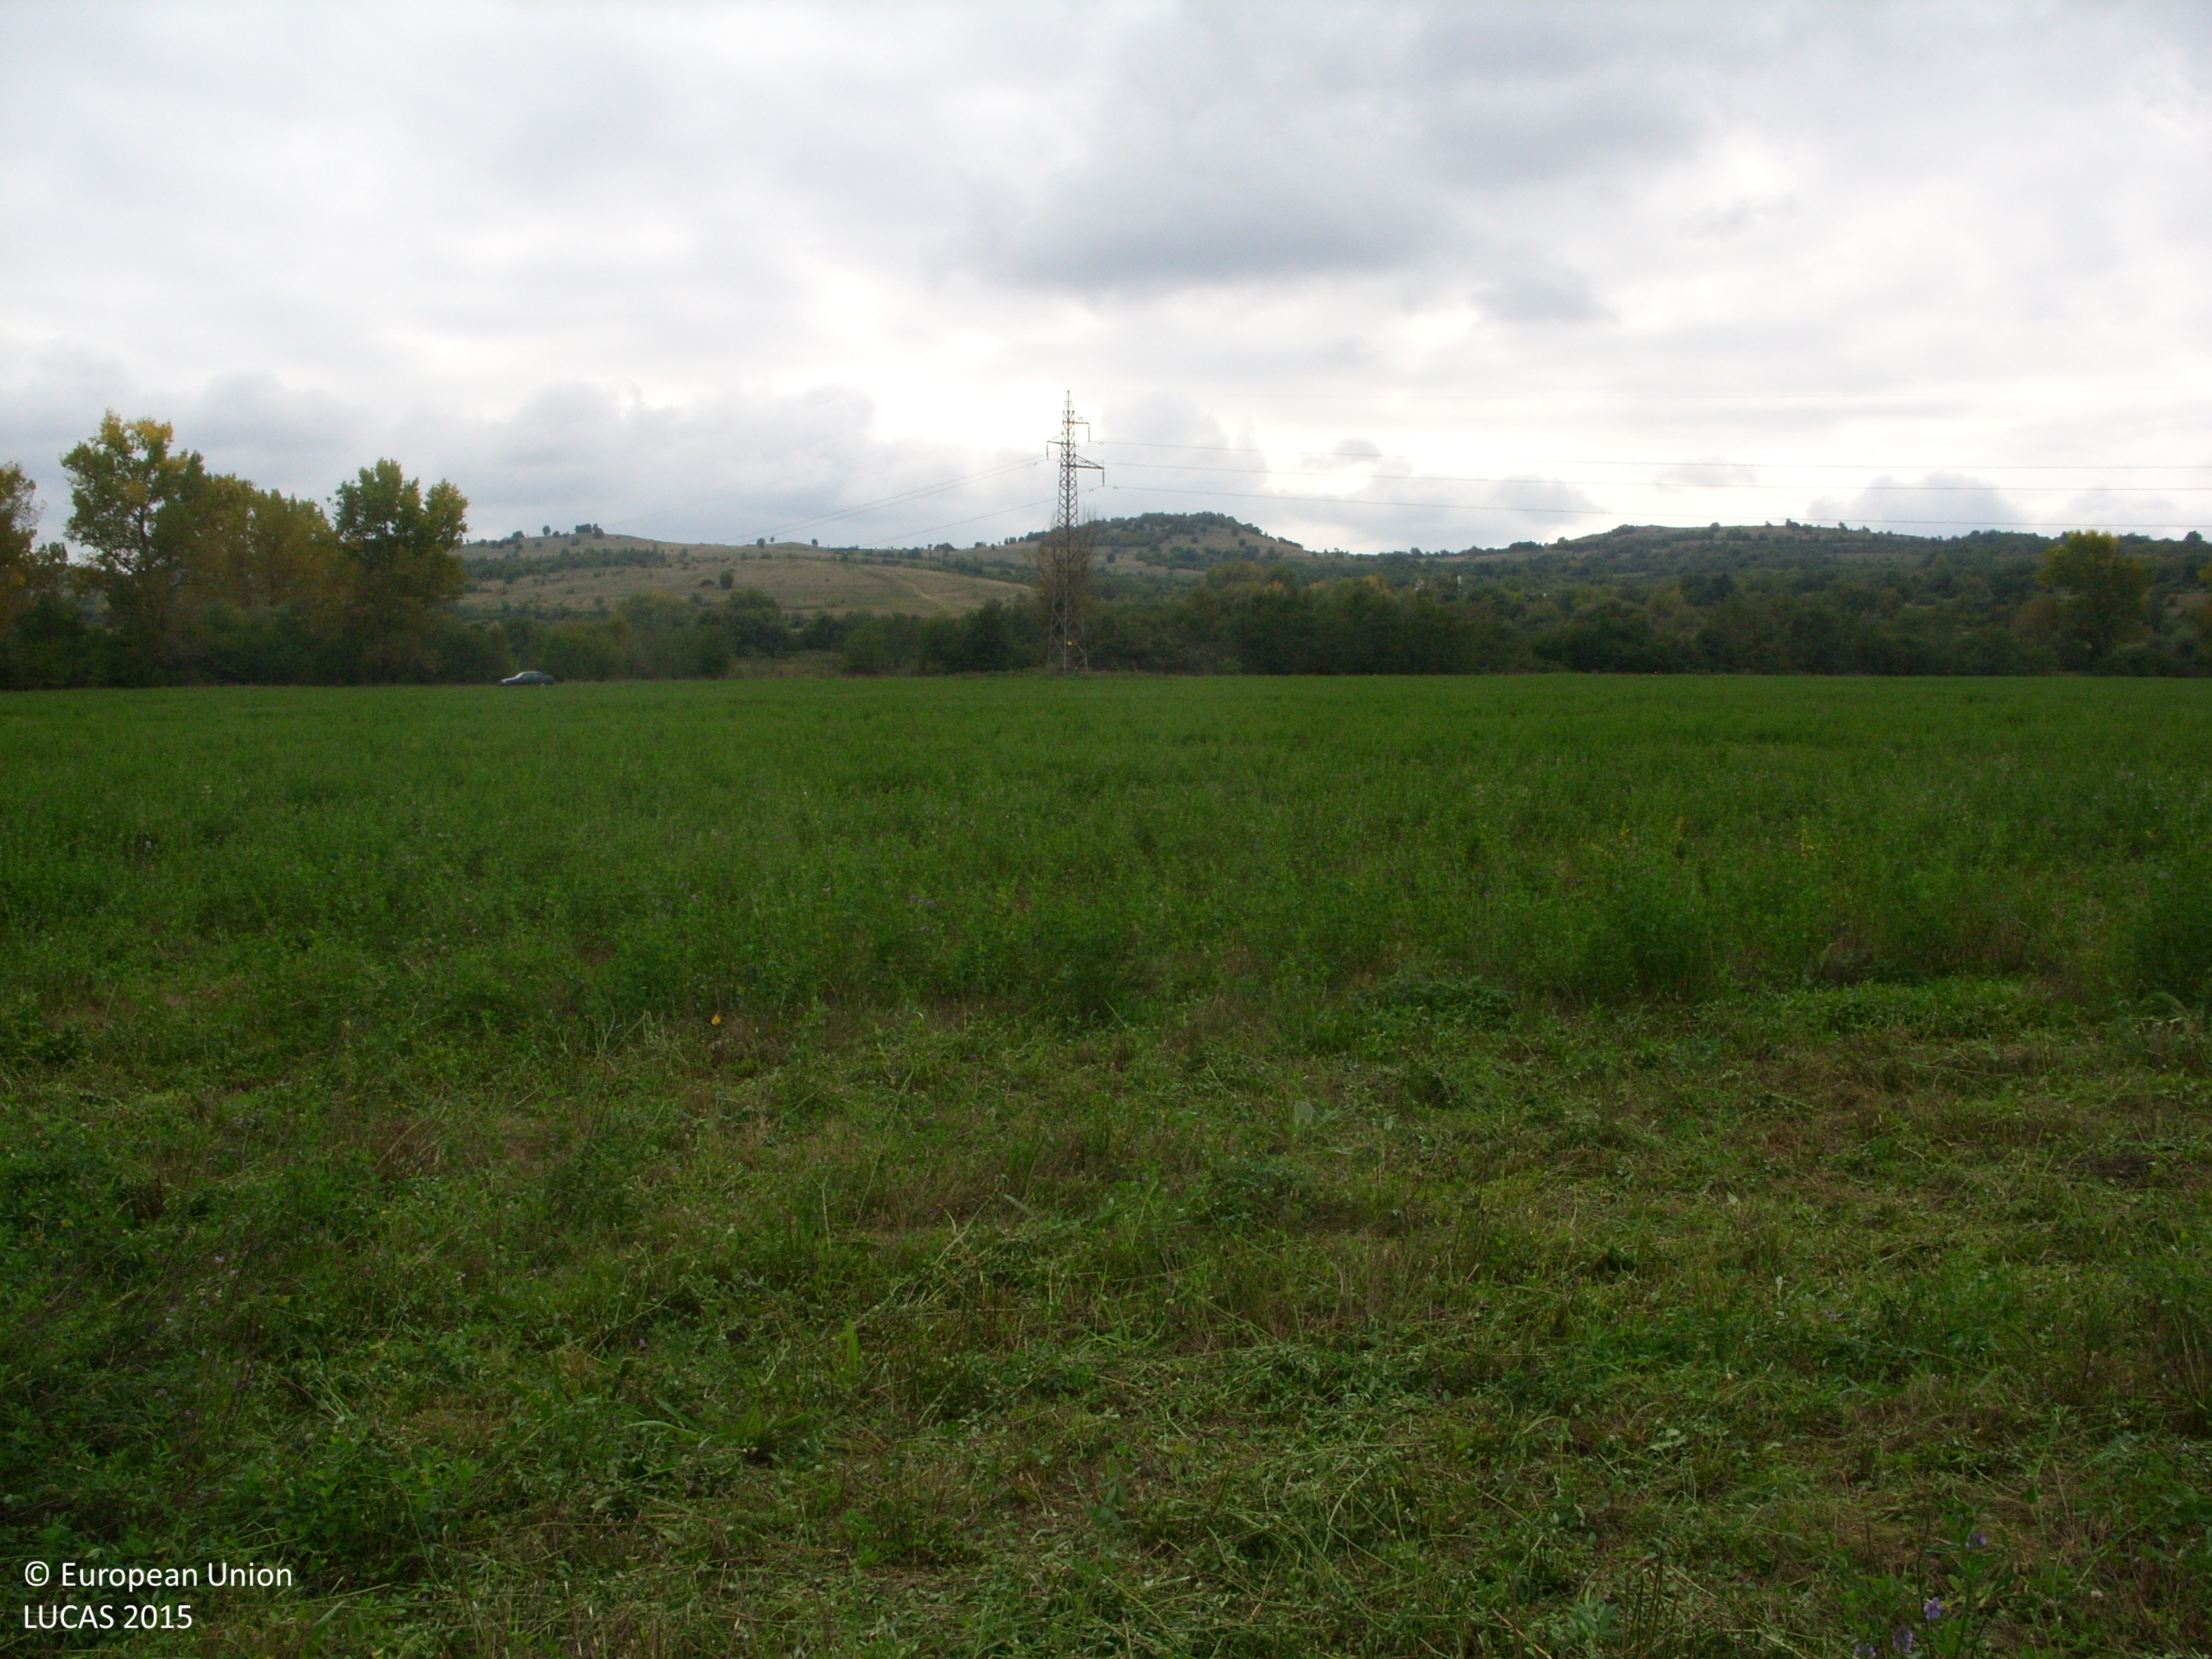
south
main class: Cropland
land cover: Lucerne
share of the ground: > 75 %
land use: Agriculture (excluding fallow land and kitchen gardens)
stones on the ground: < 10 %
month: October
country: BG
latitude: 42.5277
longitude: 24.8242
